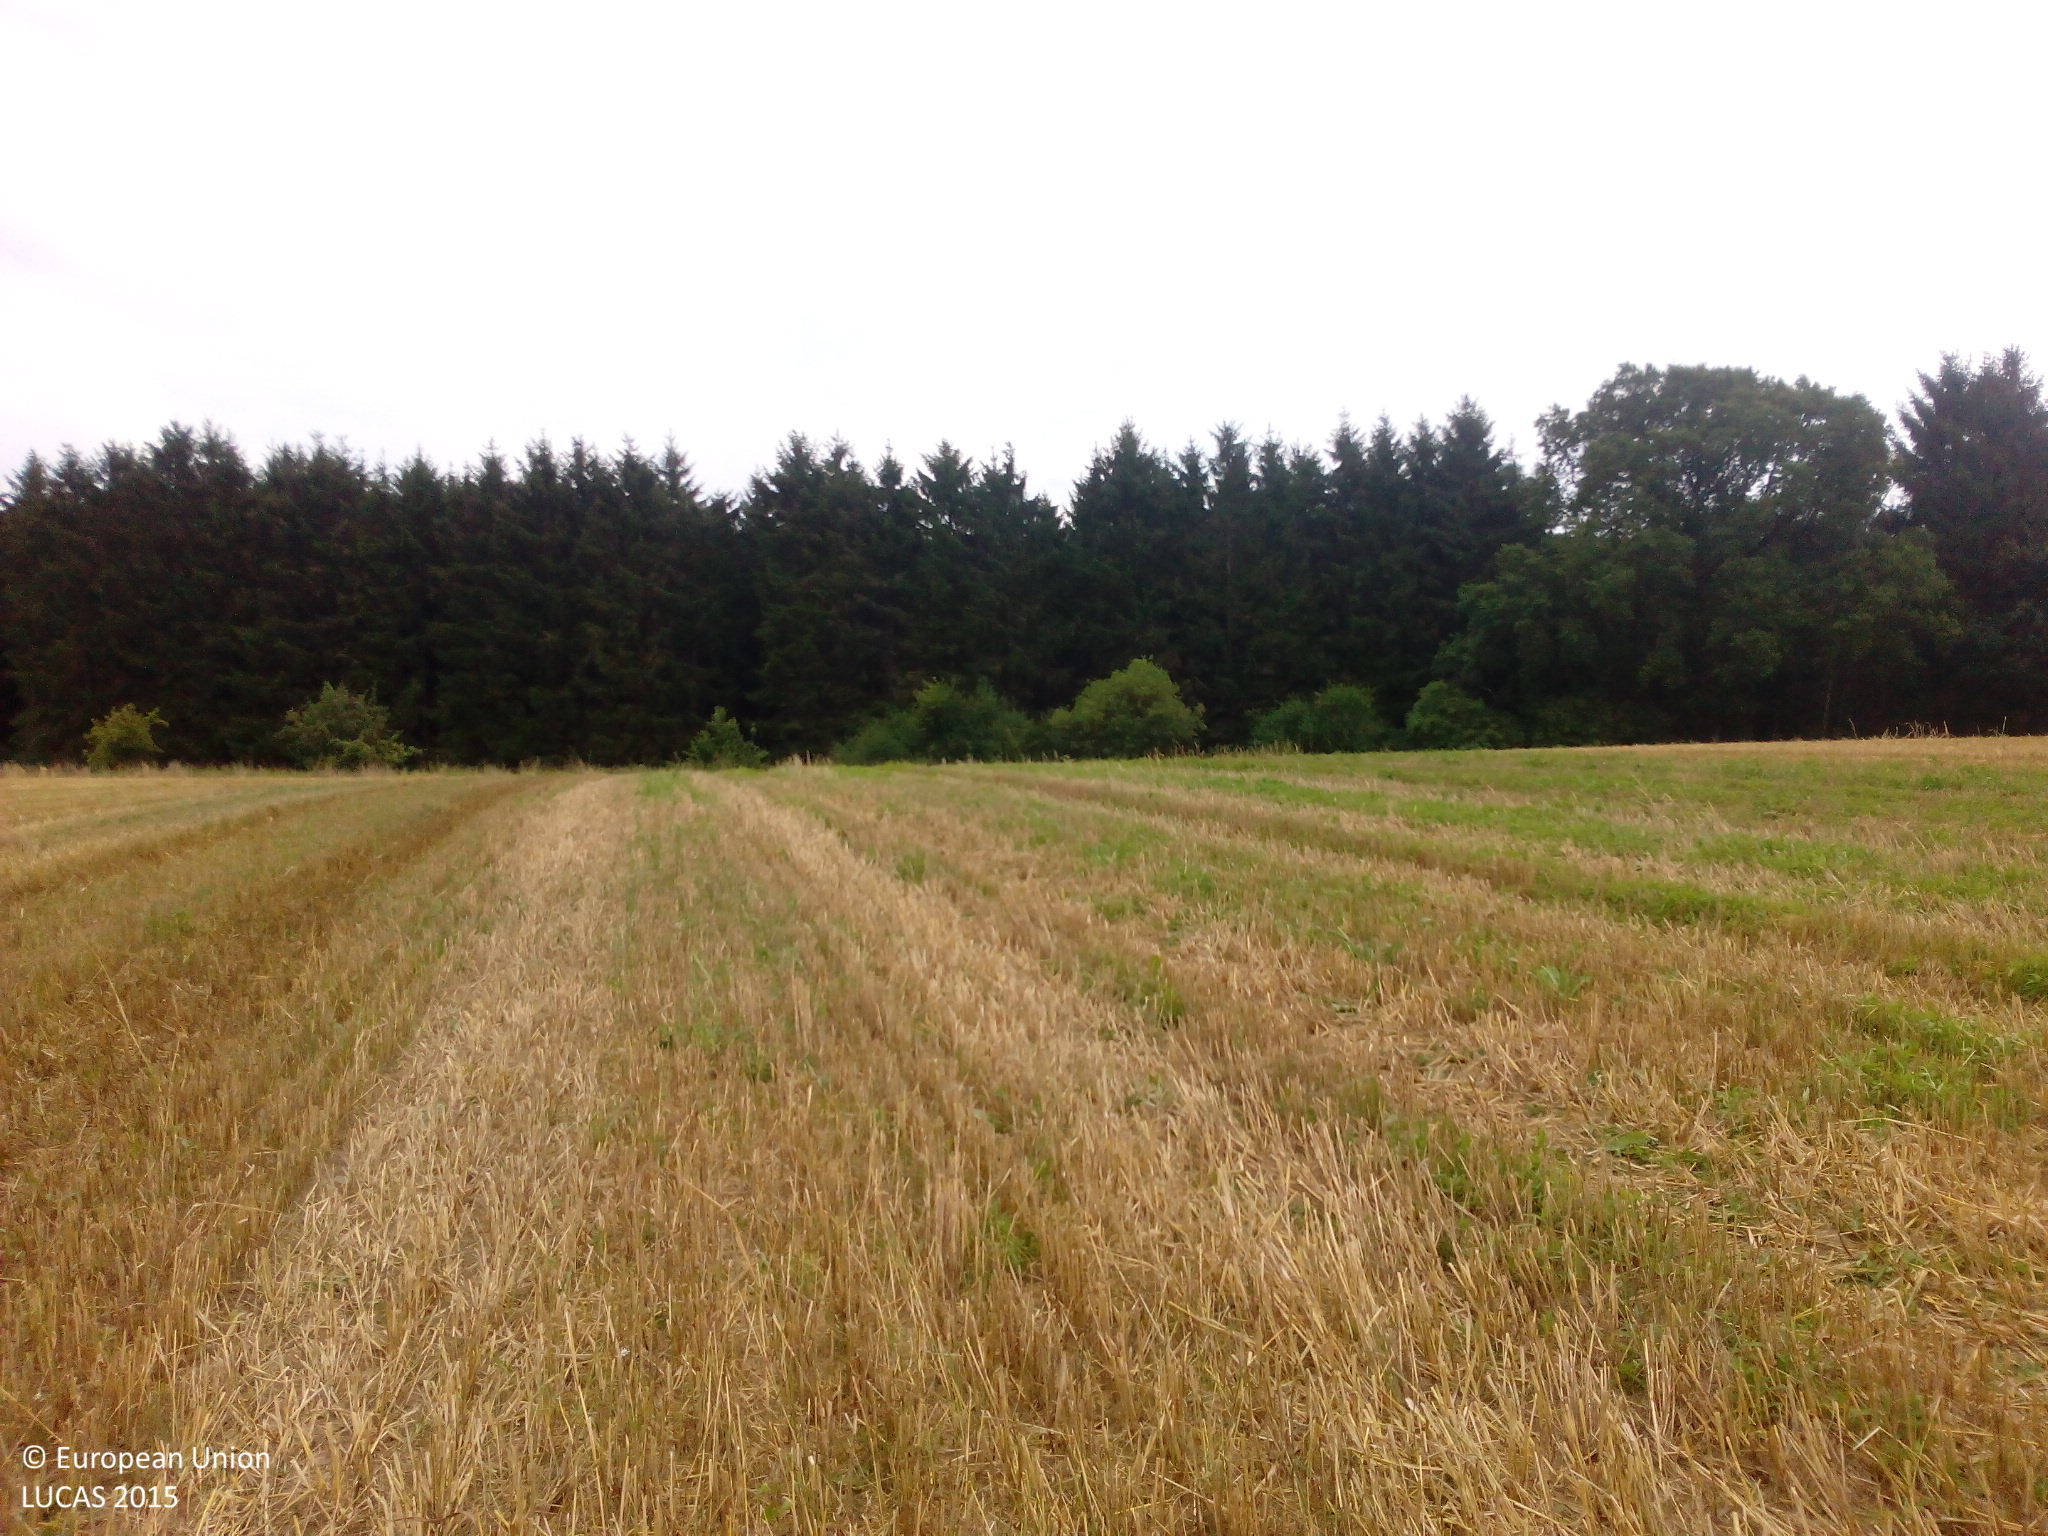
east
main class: Cropland
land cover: Barley
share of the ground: < 10 %
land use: Agriculture (excluding fallow land and kitchen gardens)
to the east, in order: Barley; Shruby margins; Tracks; Shrubland without tree cover; Spruce dominated coniferous woodland; Broadleaved woodland; Shrubland with sparse tree cover; Rivers and streams; Shrubland without tree cover; Spruce dominated coniferous woodland
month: August
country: DE
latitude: 51.8364
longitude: 9.3471
